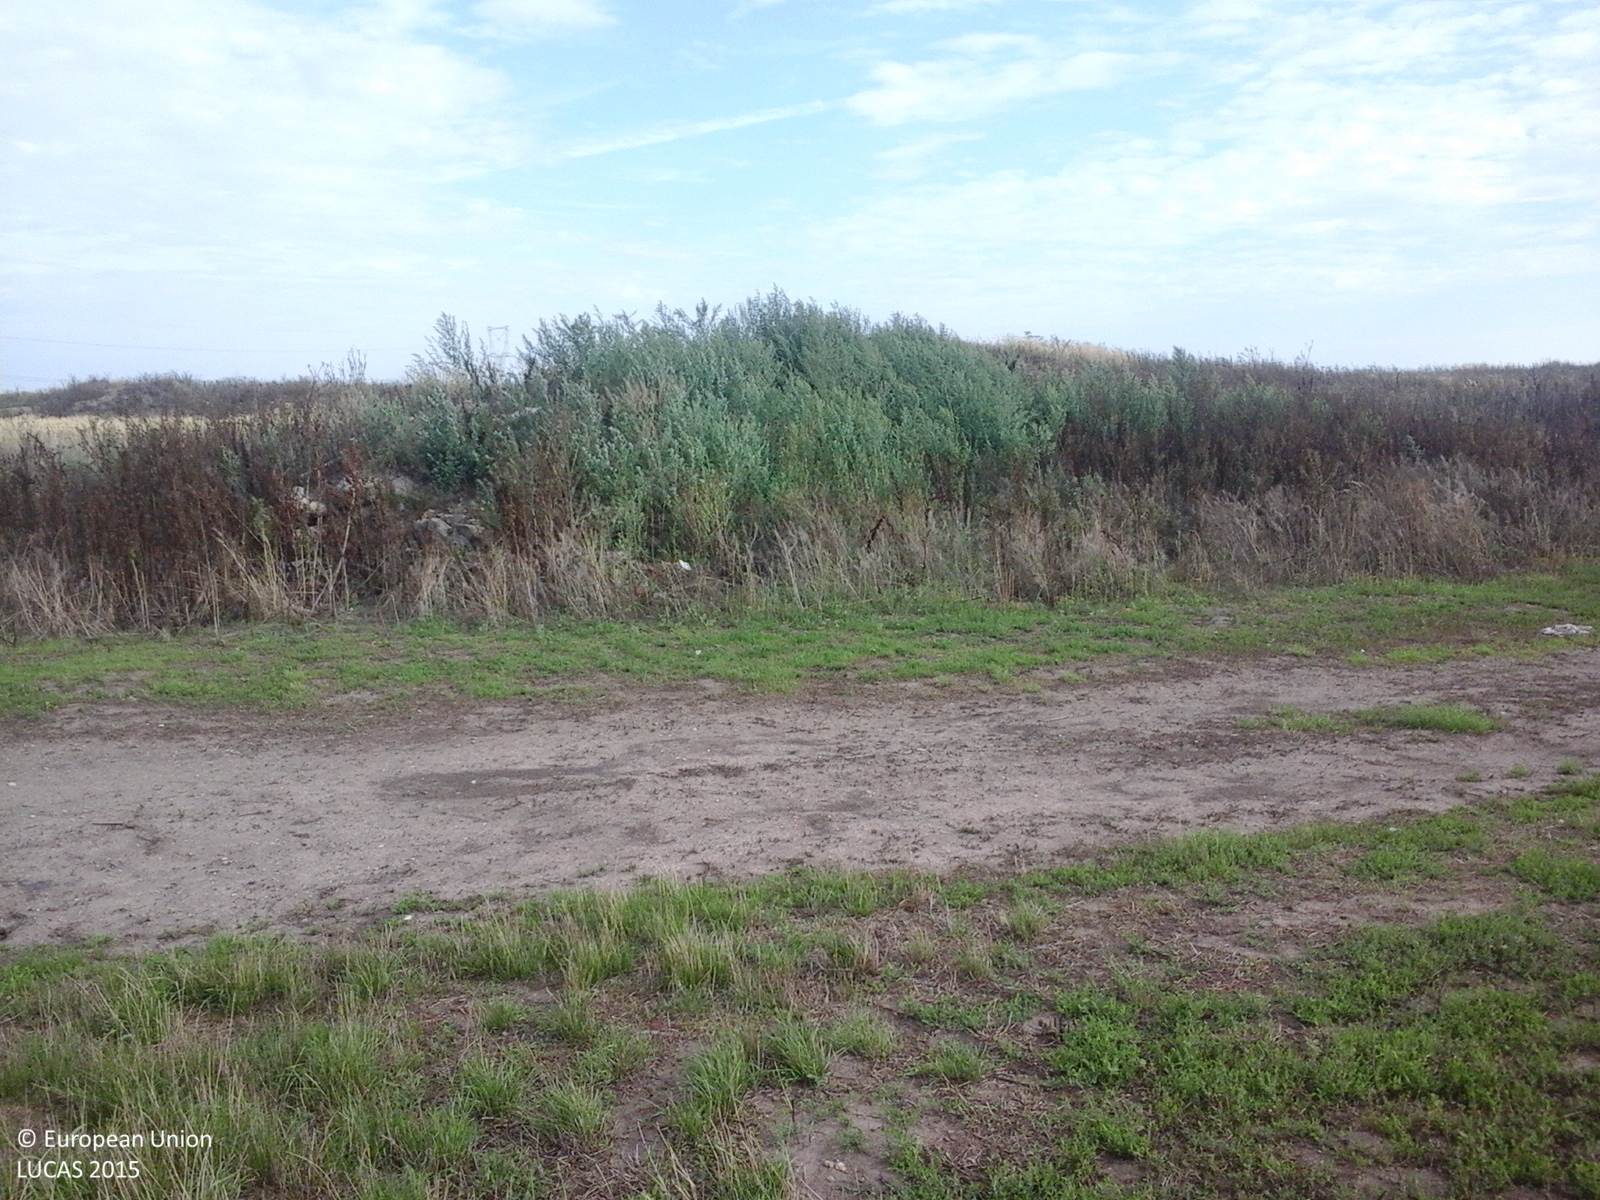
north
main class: Grassland
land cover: Grassland without tree/shrub cover
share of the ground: > 75 %
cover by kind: herbaceous plants 100 %
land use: Agriculture (excluding fallow land and kitchen gardens)
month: August
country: RO
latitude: 46.2626
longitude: 21.4399
